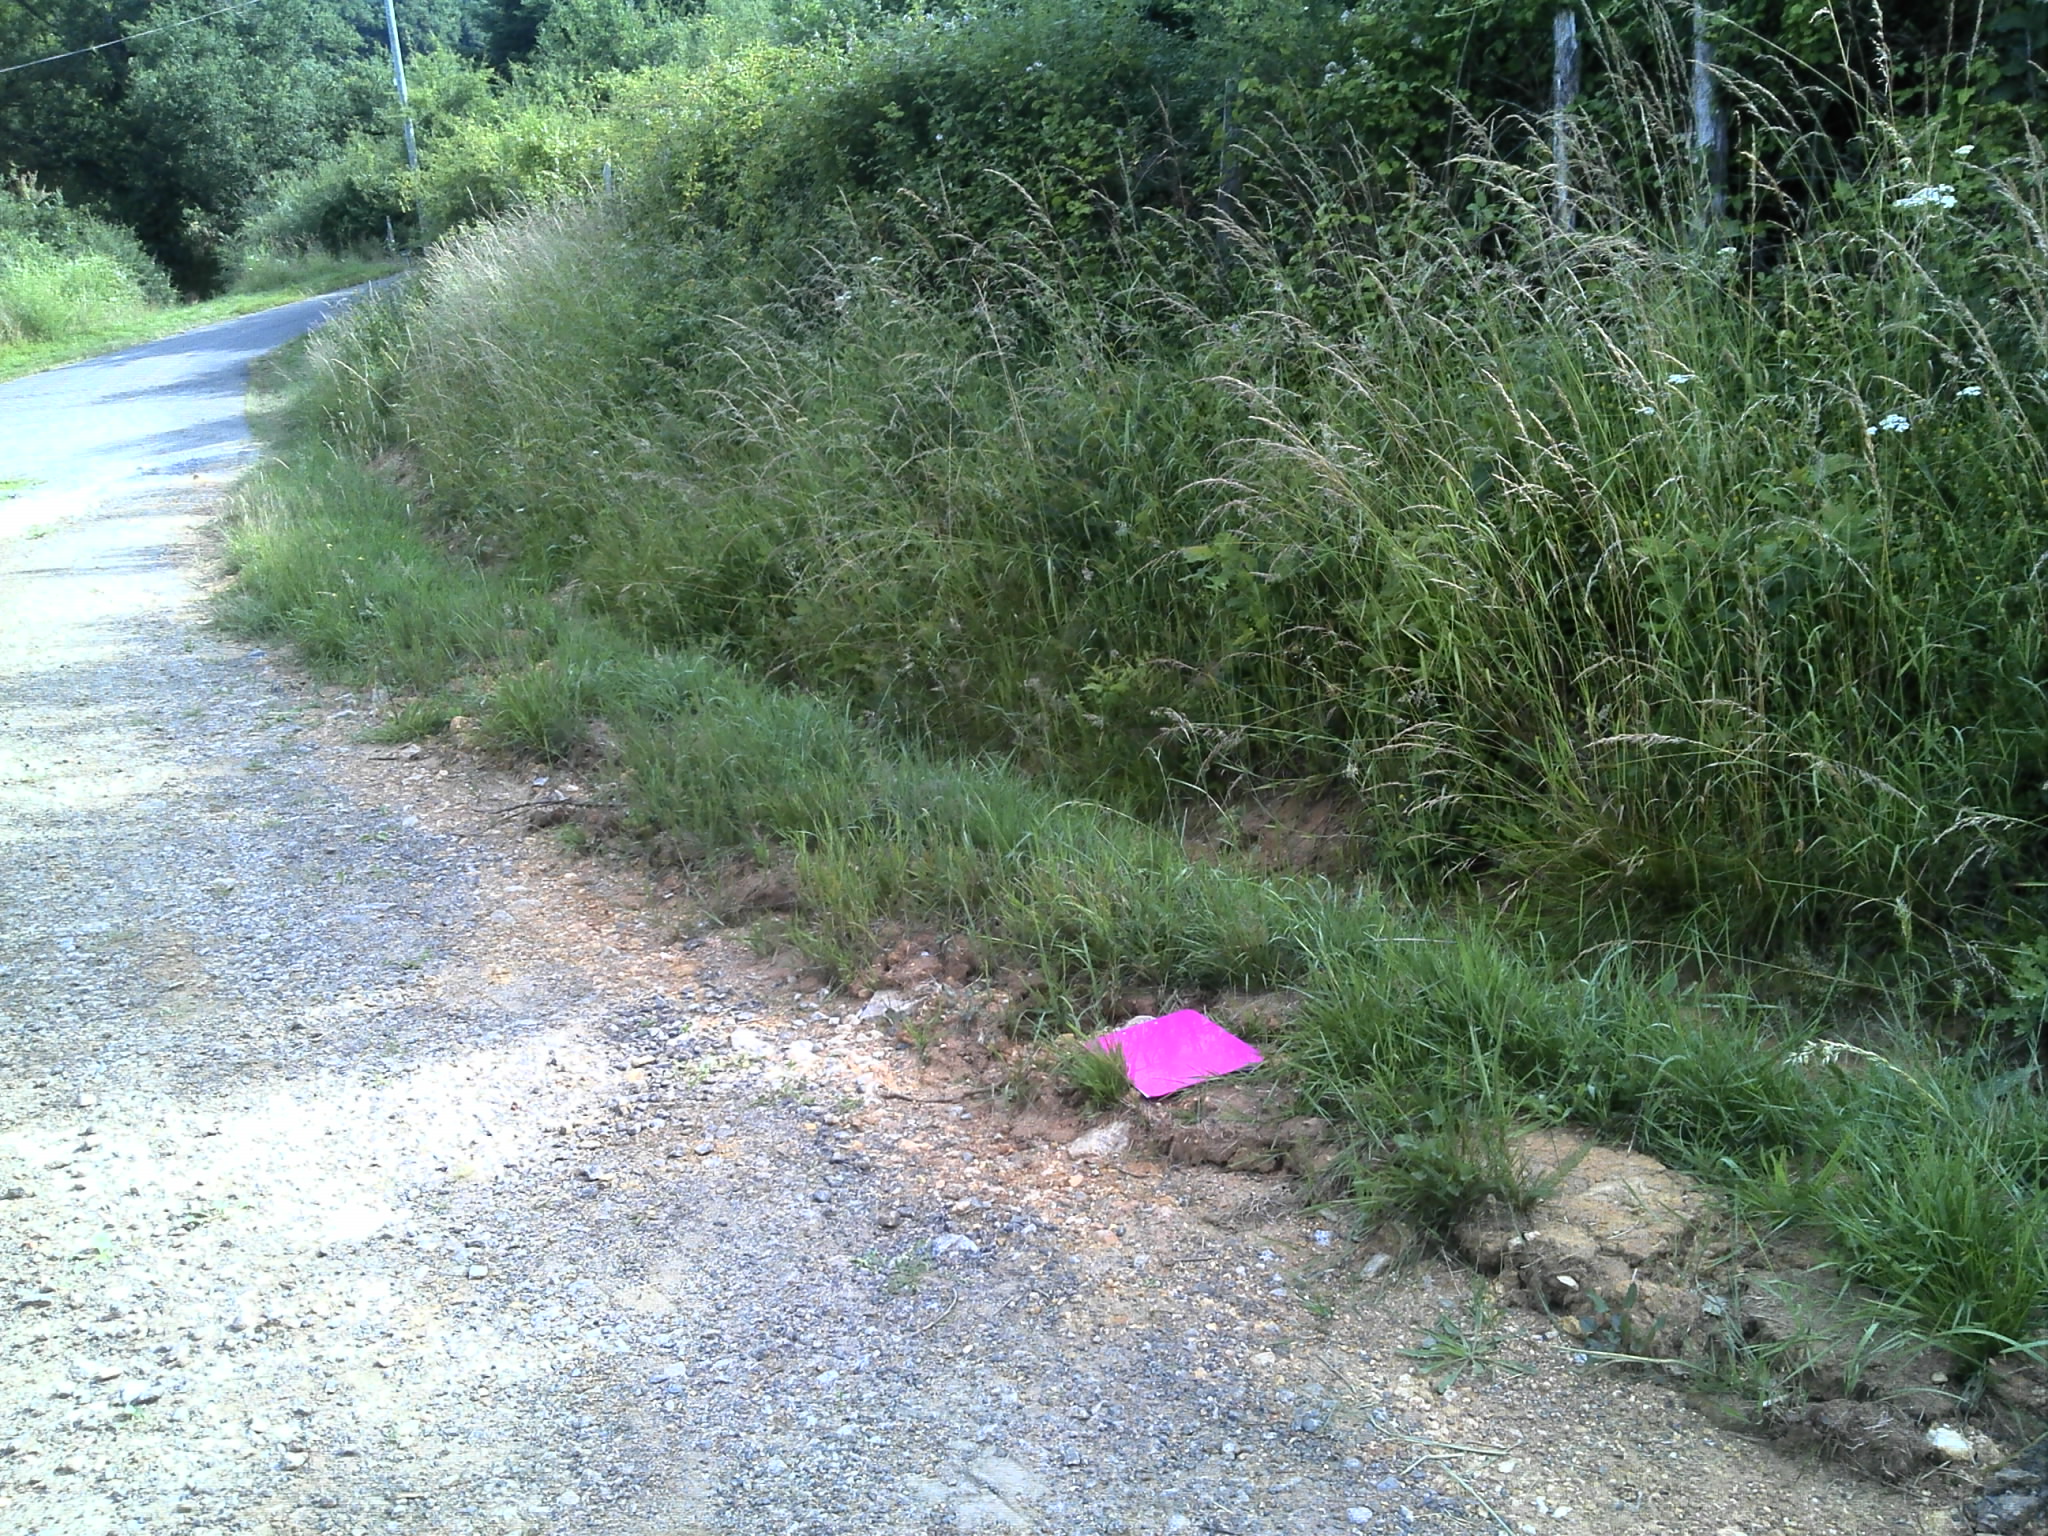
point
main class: Woodland
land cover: Broadleaved woodland
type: mesophytic deciduous forest
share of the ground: > 75 %
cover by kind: broadleaved forest trees 50 %, shrubs 50 %
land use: Semi-natural and natural areas not in use
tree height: < 5 m
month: June
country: FR
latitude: 46.5575
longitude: 1.5241
